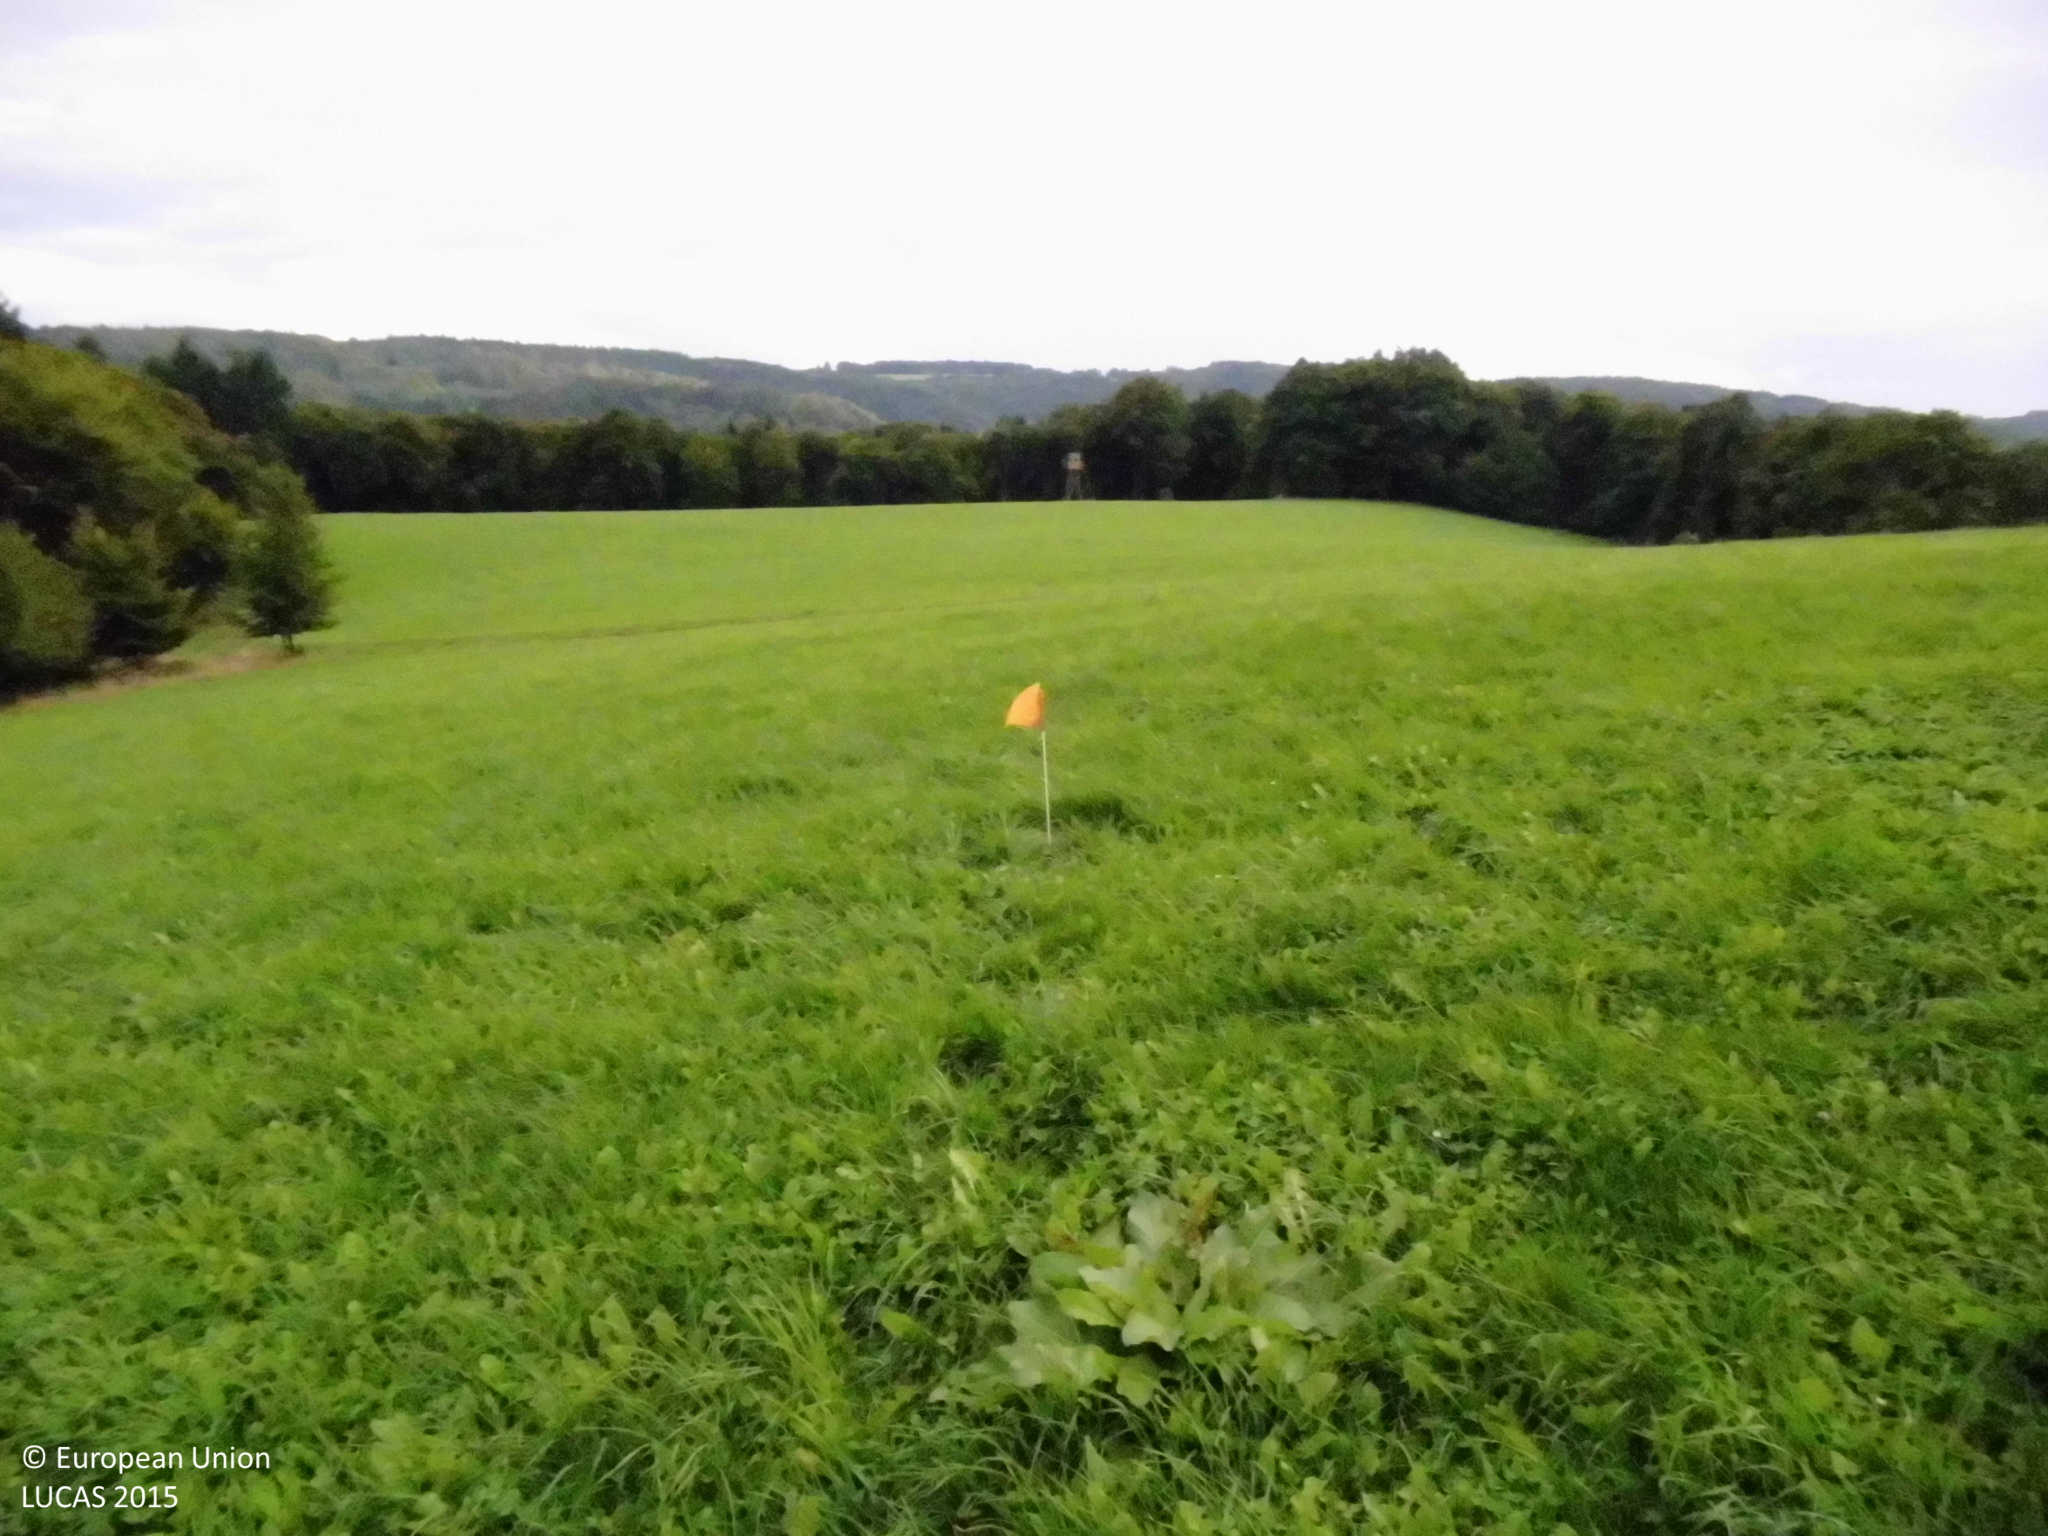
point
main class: Grassland
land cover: Grassland without tree/shrub cover
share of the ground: > 75 %
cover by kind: herbaceous plants 100 %
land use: Agriculture (excluding fallow land and kitchen gardens)
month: September
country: DE
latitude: 50.5514
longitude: 7.4456
